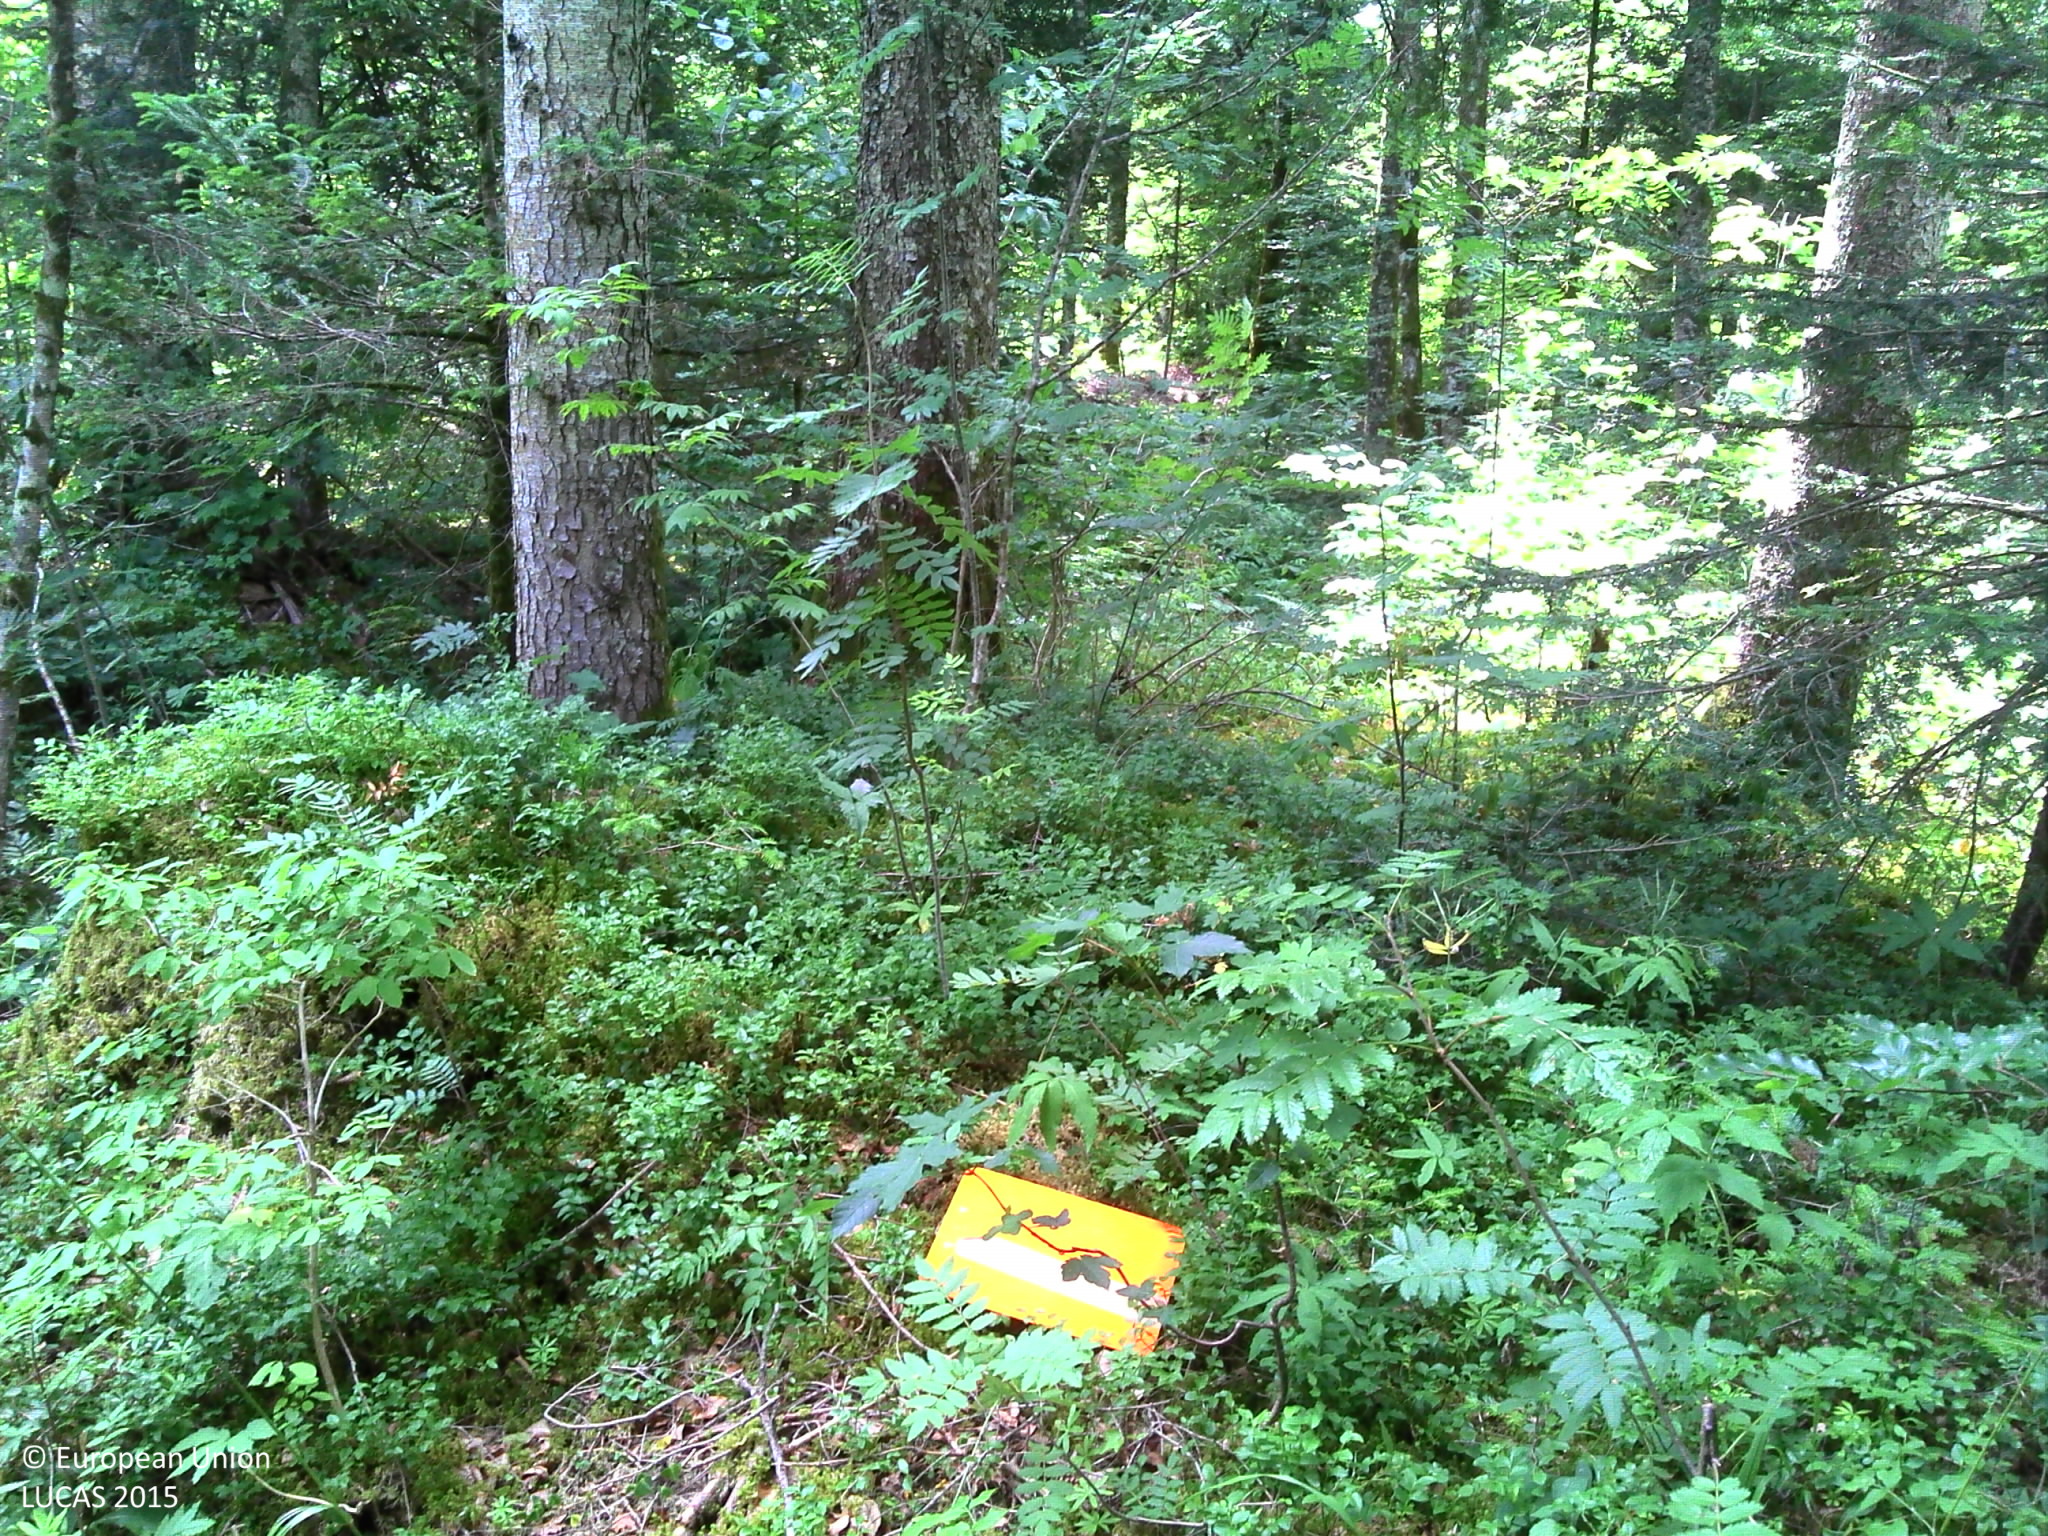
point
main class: Woodland
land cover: Other mixed woodland
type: mountainous beech forest
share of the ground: > 75 %
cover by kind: coniferous forest trees 30 %, broadleaved forest trees 30 %, lichens and mosses 15 %, consolidated bare surface 15 %, herbaceous plants 10 %
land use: Forestry
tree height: > 5 m
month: July
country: FR
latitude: 46.7513
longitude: 6.1670
